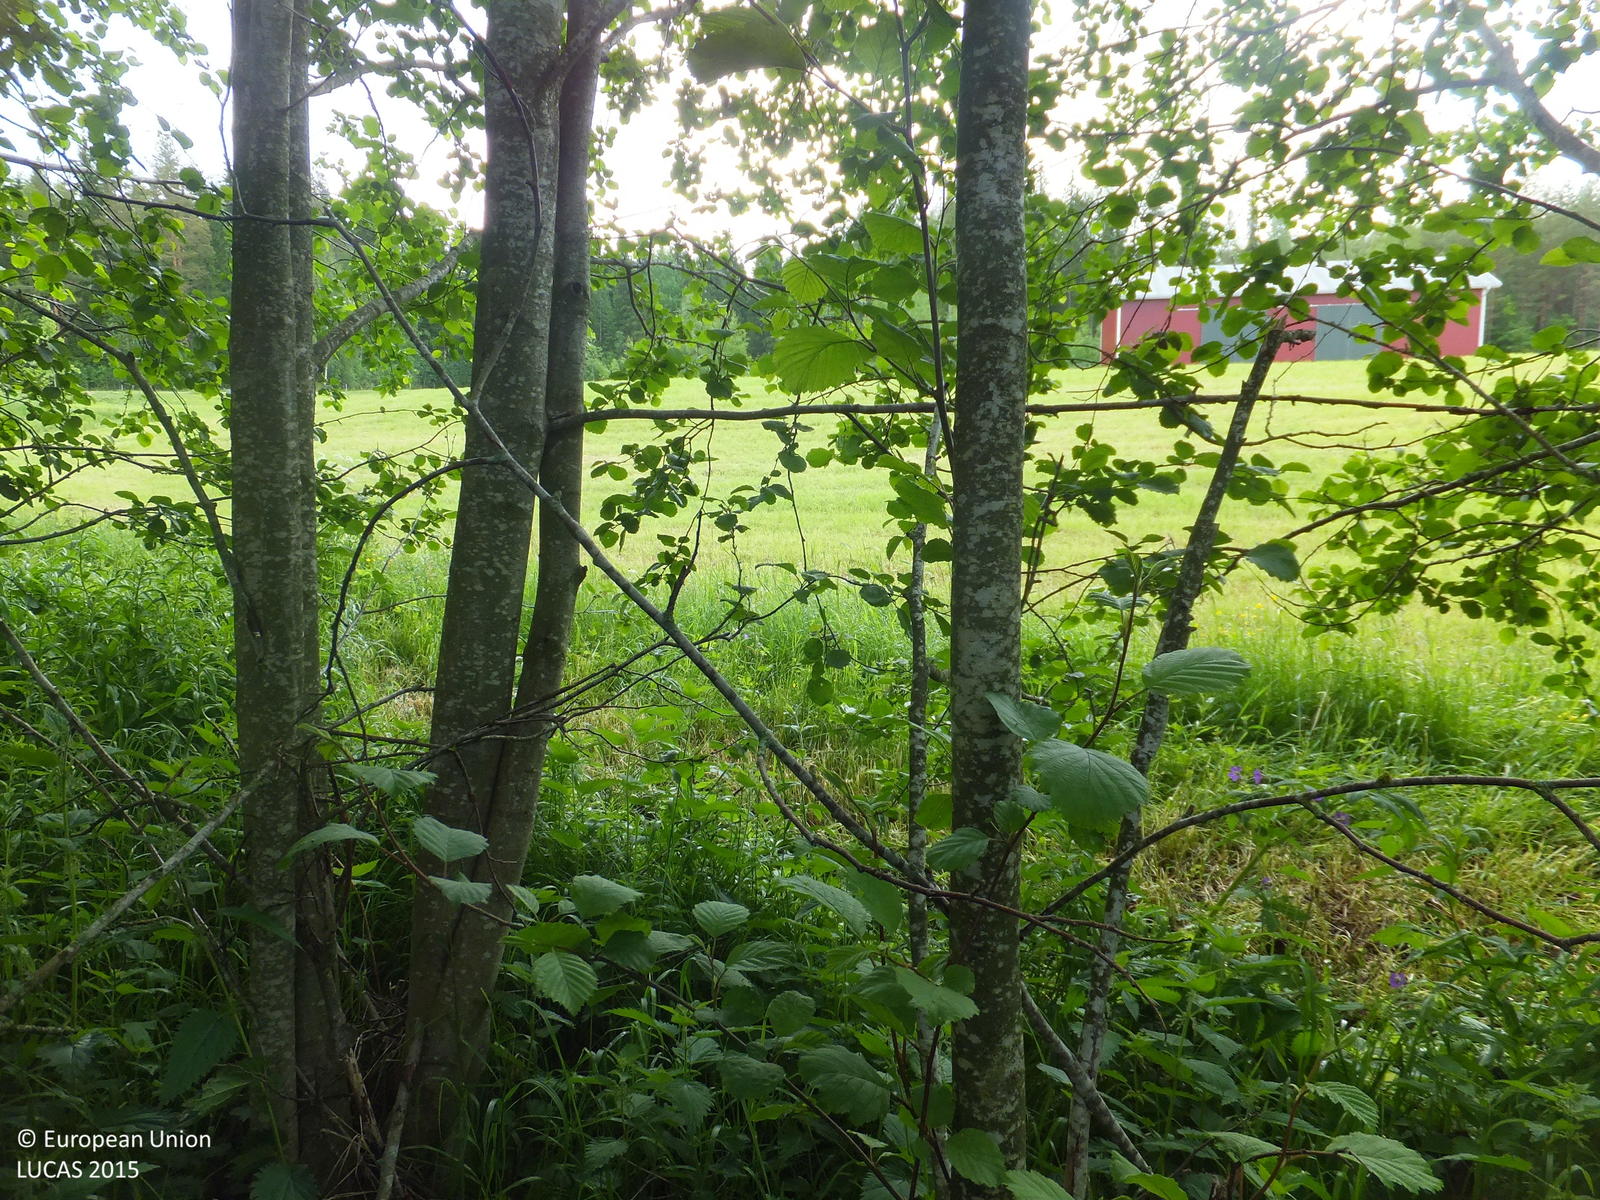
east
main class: Woodland
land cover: Broadleaved woodland
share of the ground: 50 - 75 %
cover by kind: broadleaved forest trees 60 %, herbaceous plants 40 %
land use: Semi-natural and natural areas not in use
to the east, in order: Broadleaved woodland; Grassland without tree/shrub cover; Tracks; Temporary grasslands; Ditches and canals; Other mixed woodland; Spruce dominated mixed woodland; Other mixed woodland; Ditches and canals
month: June
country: FI
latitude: 63.3293
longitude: 24.0309
